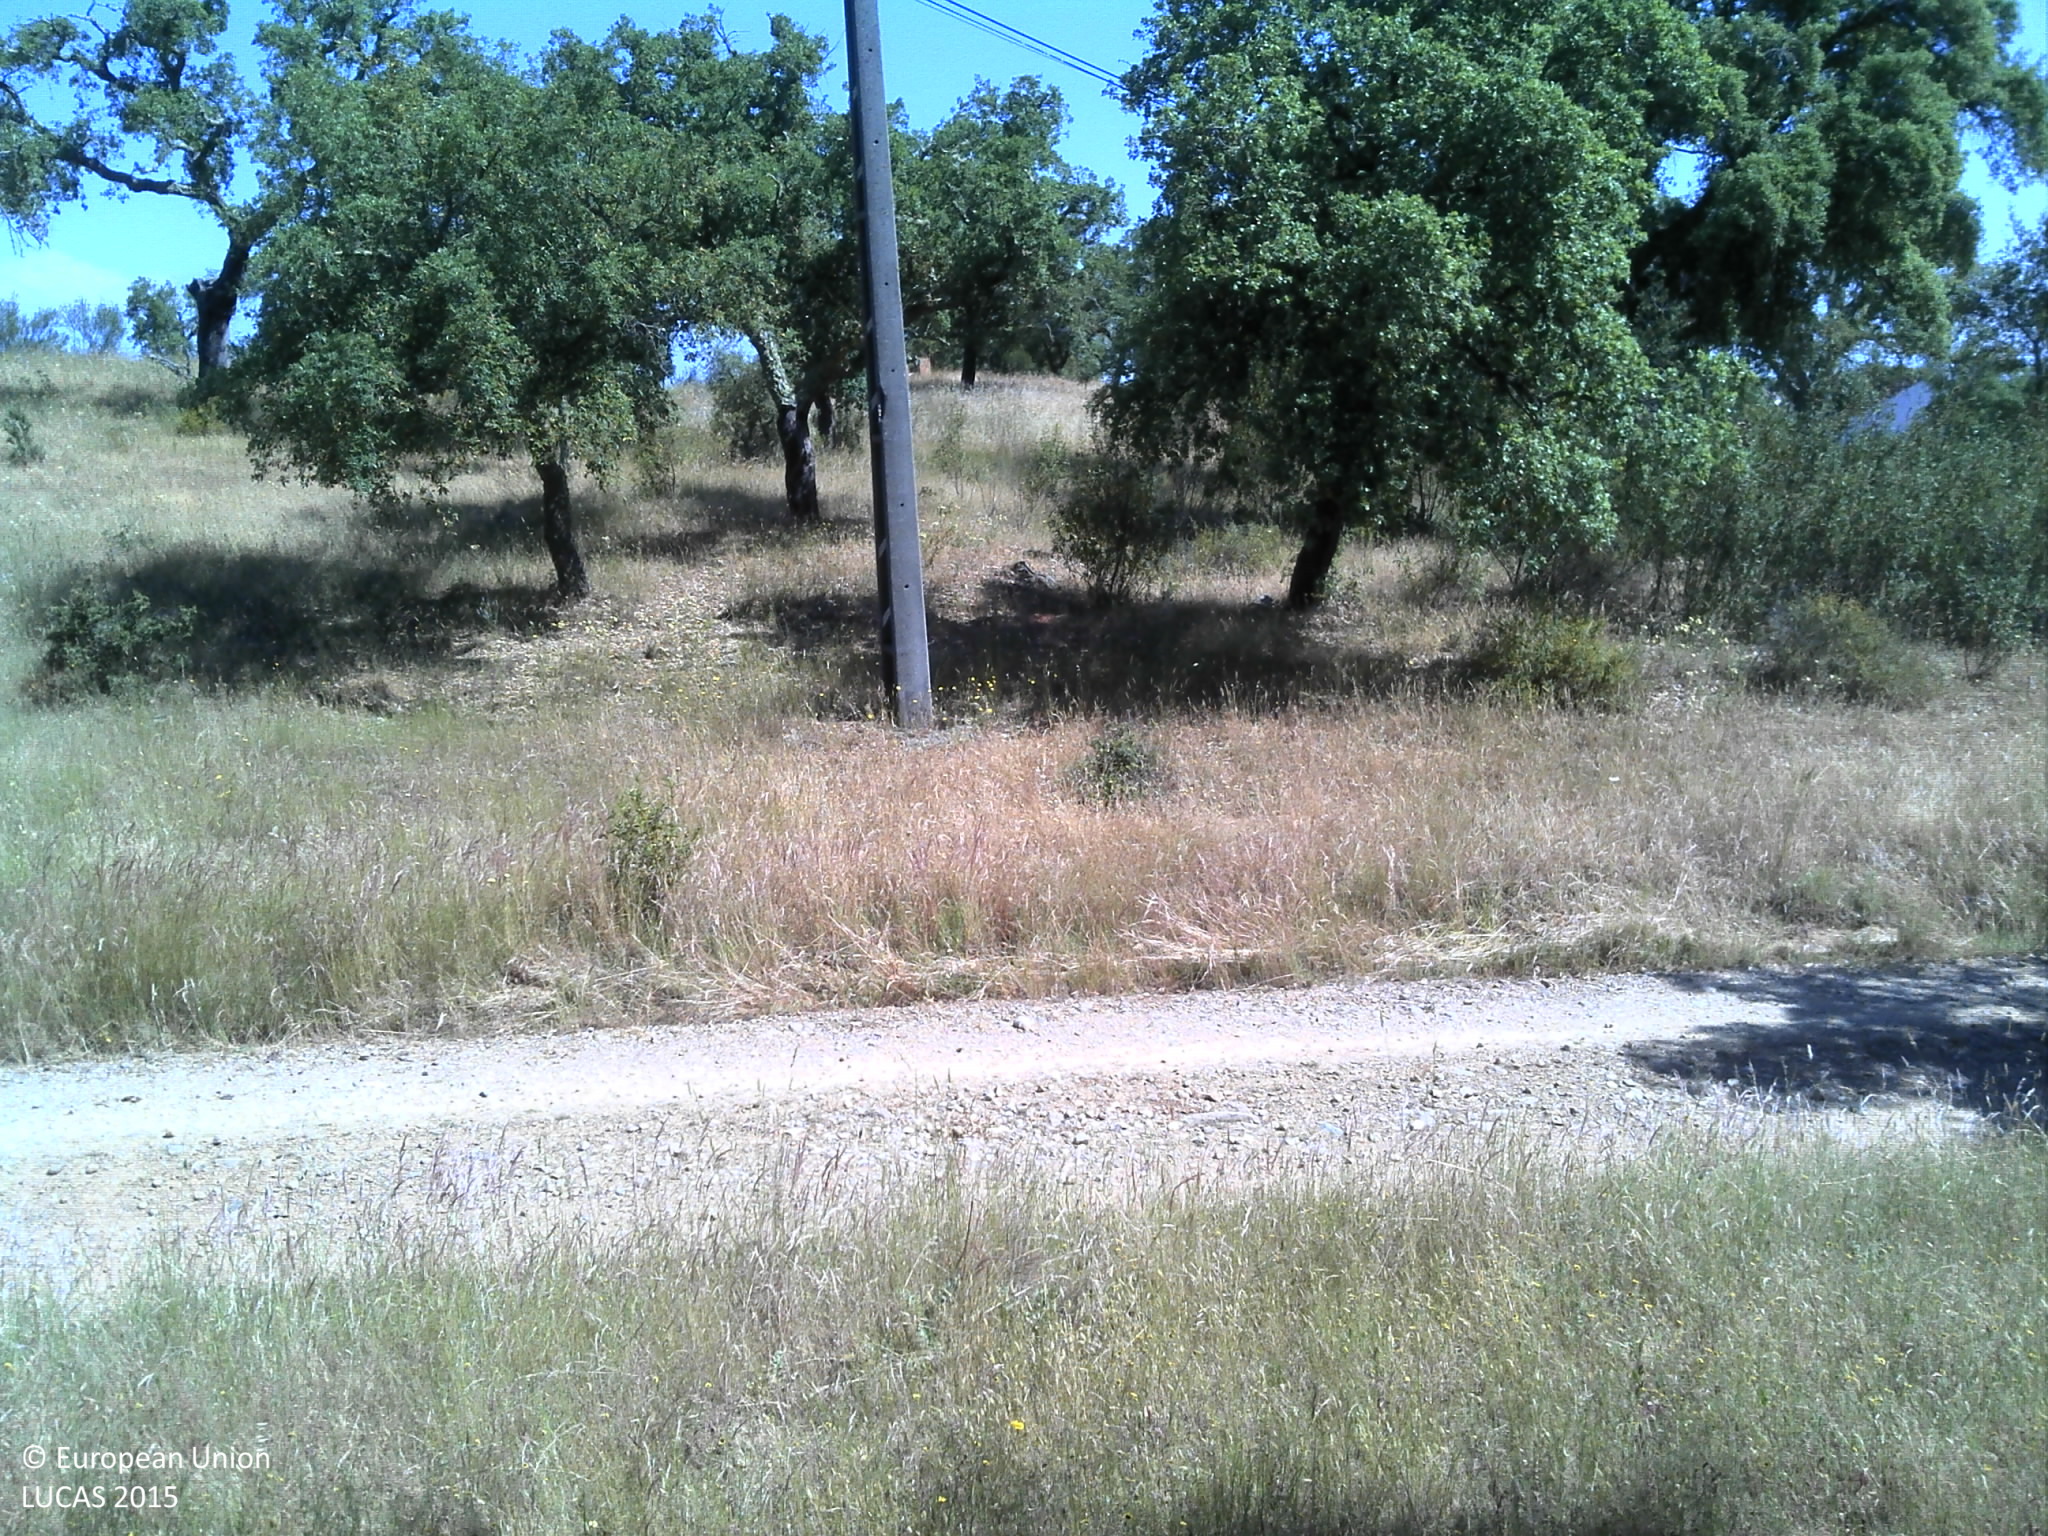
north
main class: Woodland
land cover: Broadleaved woodland
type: broadleaved evergreen forest
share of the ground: 25 - 50 %
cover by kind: broadleaved forest trees 40 %, herbaceous plants 30 %, unconsolidated bare surface 25 %, shrubs 5 %
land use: Forestry
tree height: > 5 m
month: May
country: PT
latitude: 38.1178
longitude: -8.6062
